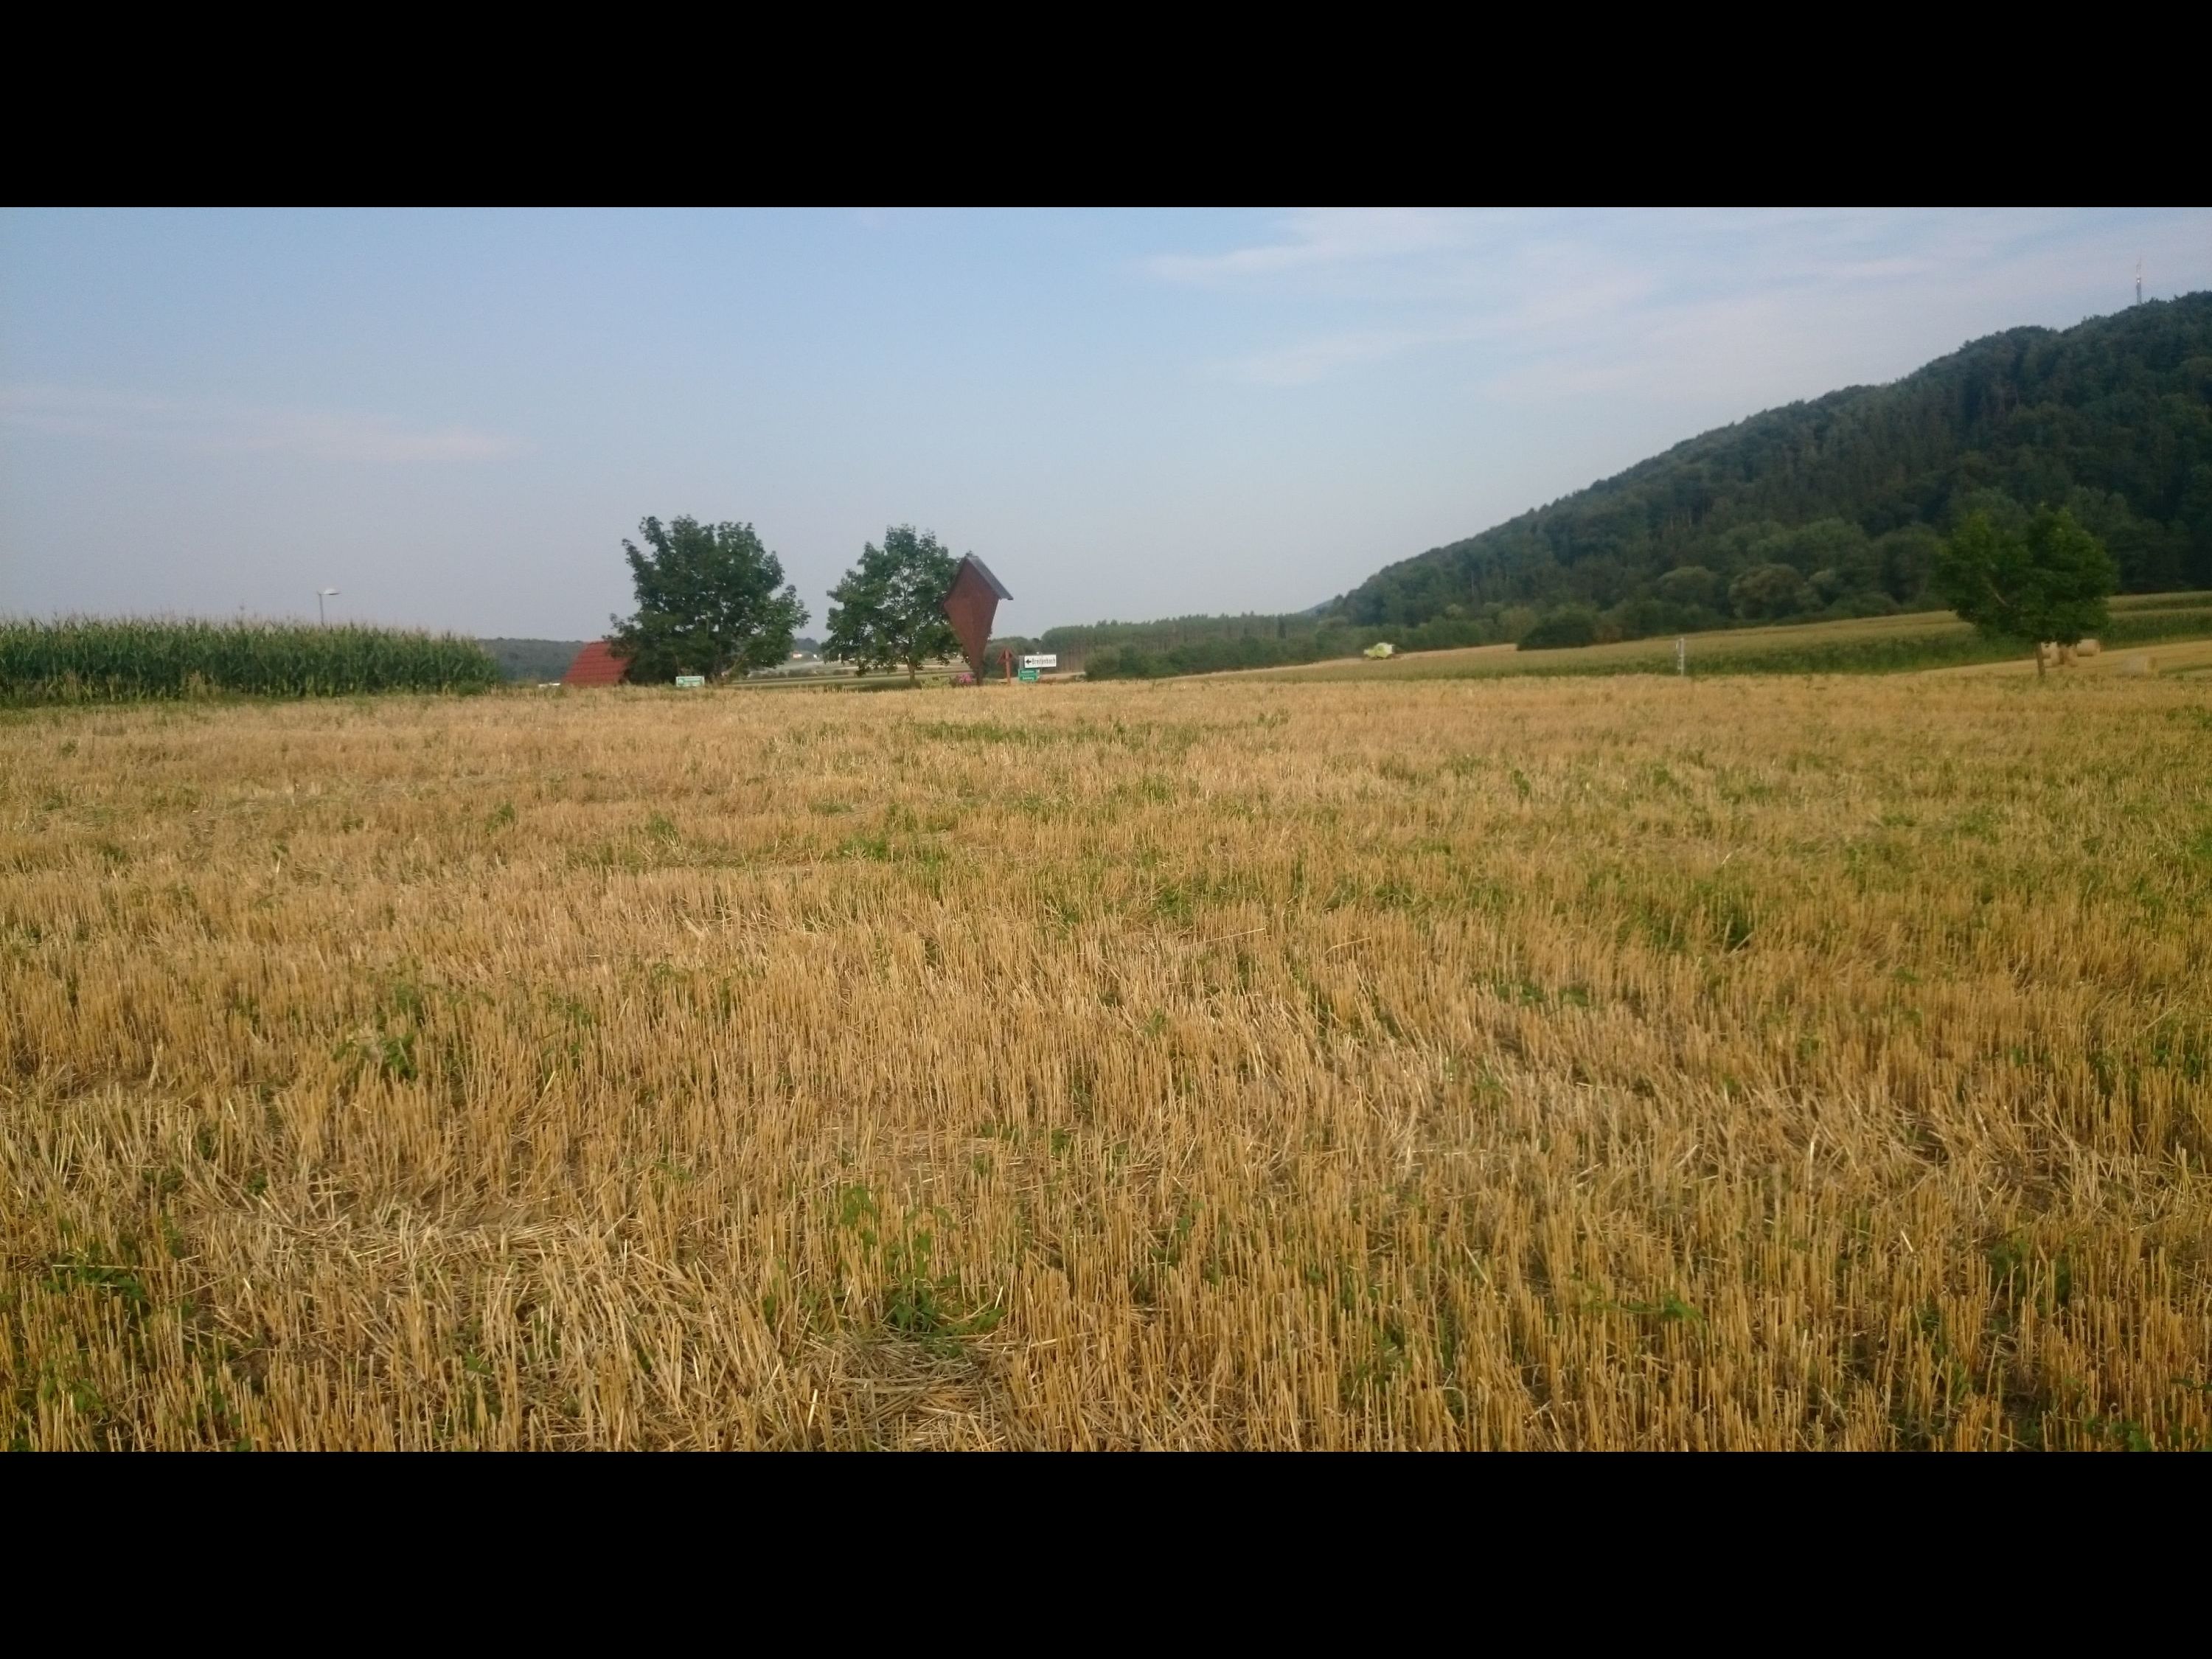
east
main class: Cropland
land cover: Common wheat
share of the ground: > 75 %
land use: Agriculture (excluding fallow land and kitchen gardens)
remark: Harvested field
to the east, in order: Common wheat; Grass margins; Paved roads, cycling and walking lanes; Ditches and canals; Grassland without tree/shrub cover; Paved roads, cycling and walking lanes; Grass margins; Maize; Grass margins; Tracks; Grass margins; Soya
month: July
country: AT
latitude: 47.0543
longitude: 15.9117
